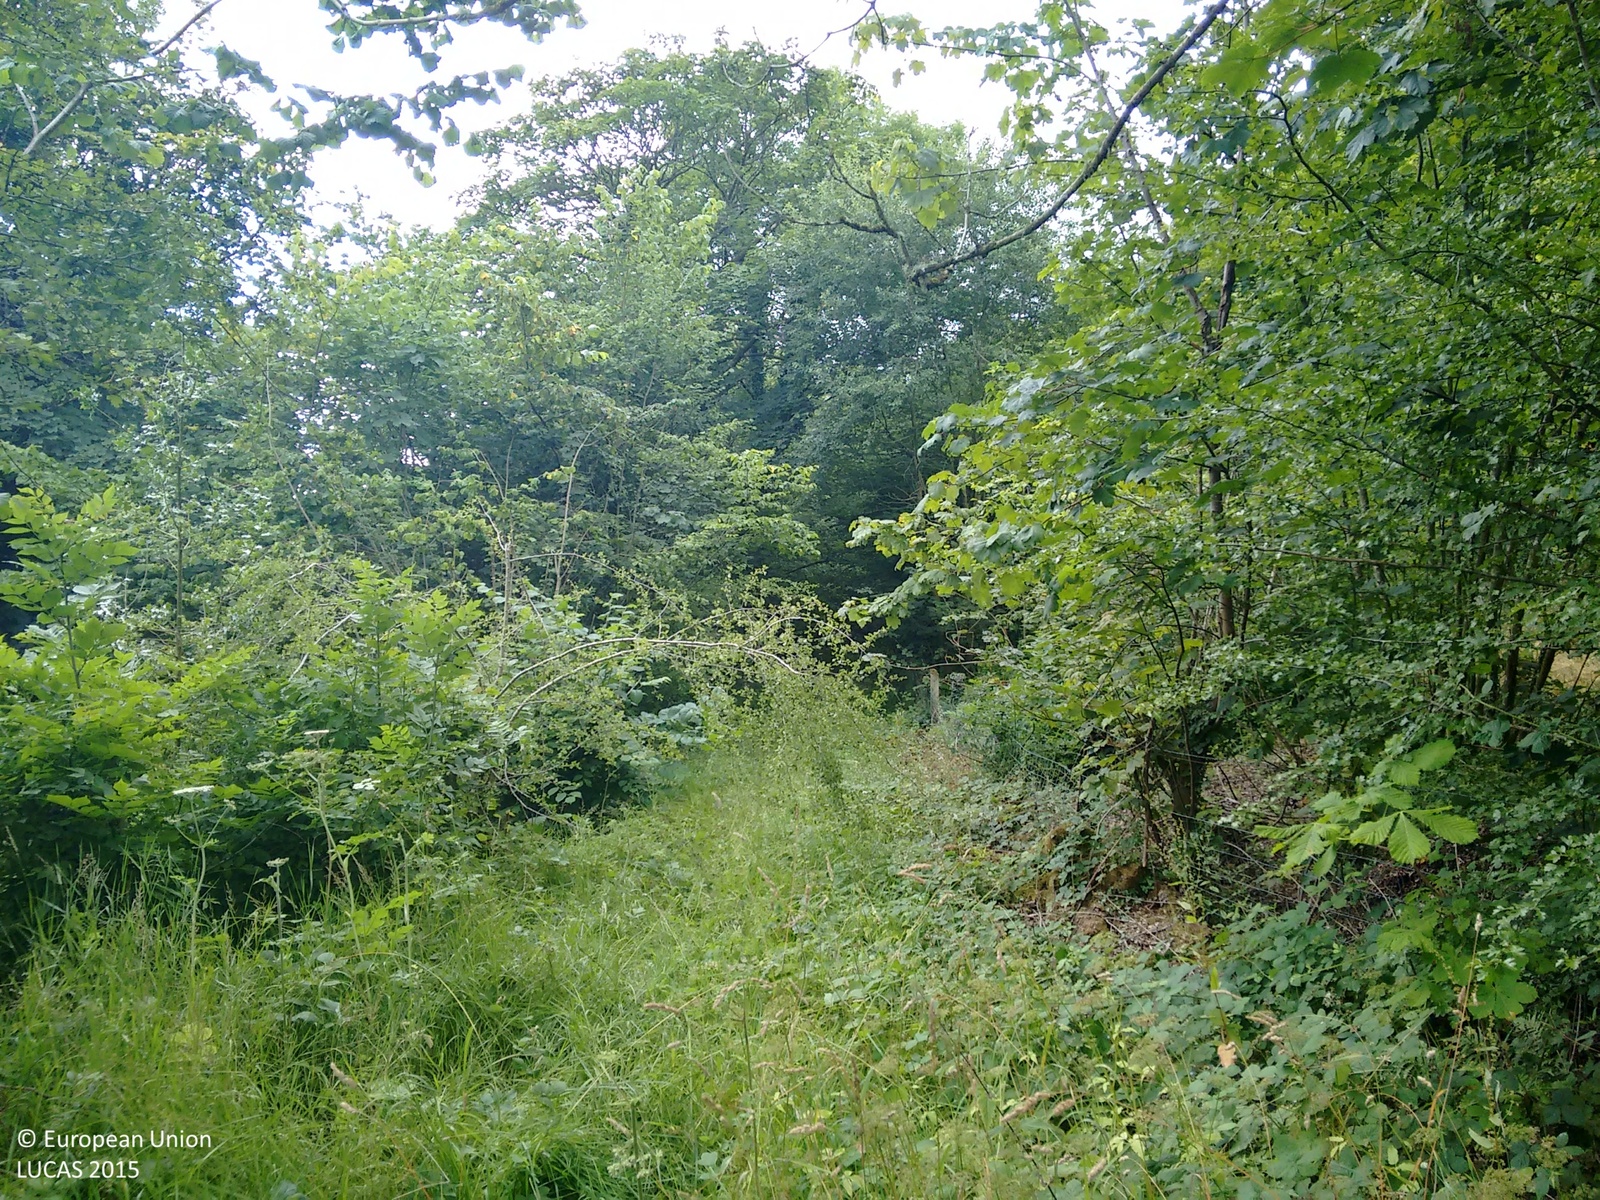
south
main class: Woodland
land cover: Broadleaved woodland
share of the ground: > 75 %
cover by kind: broadleaved forest trees 100 %
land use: Semi-natural and natural areas not in use
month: July
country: GB
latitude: 51.8717
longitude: -3.9942
